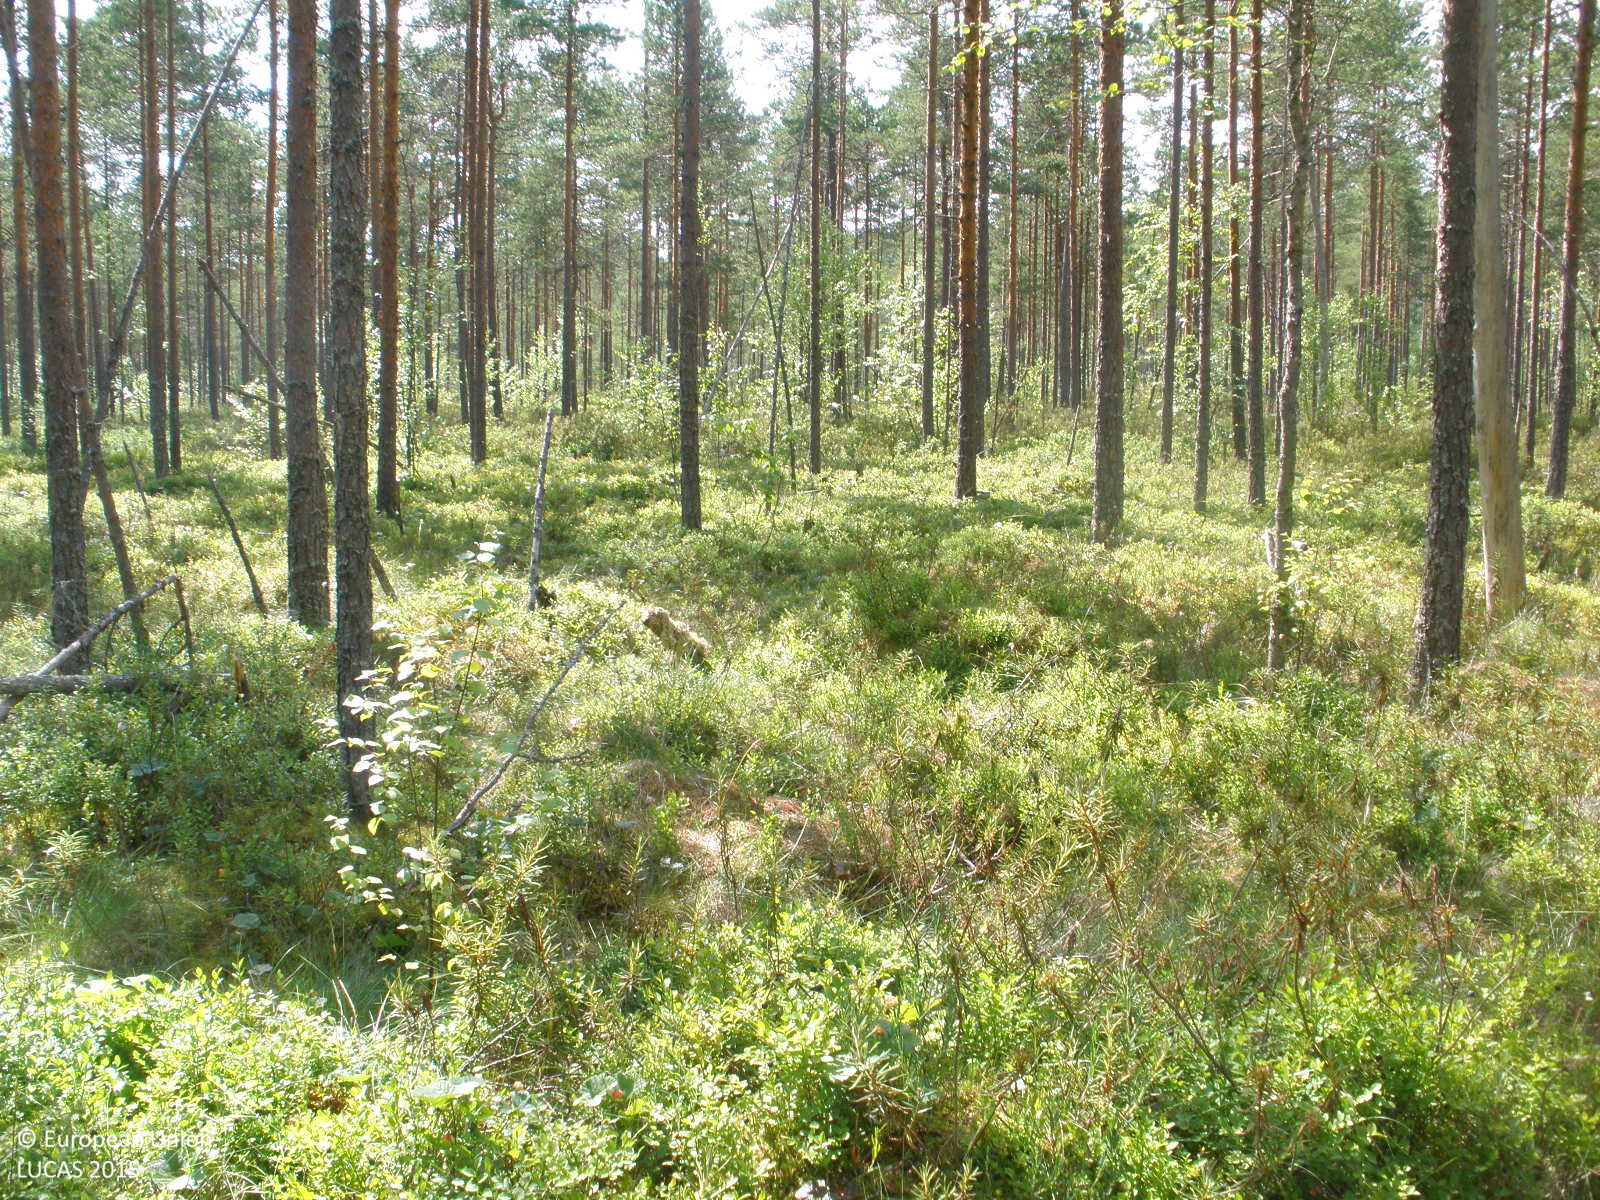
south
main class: Woodland
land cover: Pine dominated coniferous woodland
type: boreal forest
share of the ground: 50 - 75 %
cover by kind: coniferous forest trees 70 %, lichens and mosses 15 %, shrubs 10 %, herbaceous plants 5 %
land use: Forestry
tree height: > 5 m
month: July
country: FI
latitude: 61.5265
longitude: 24.7894
